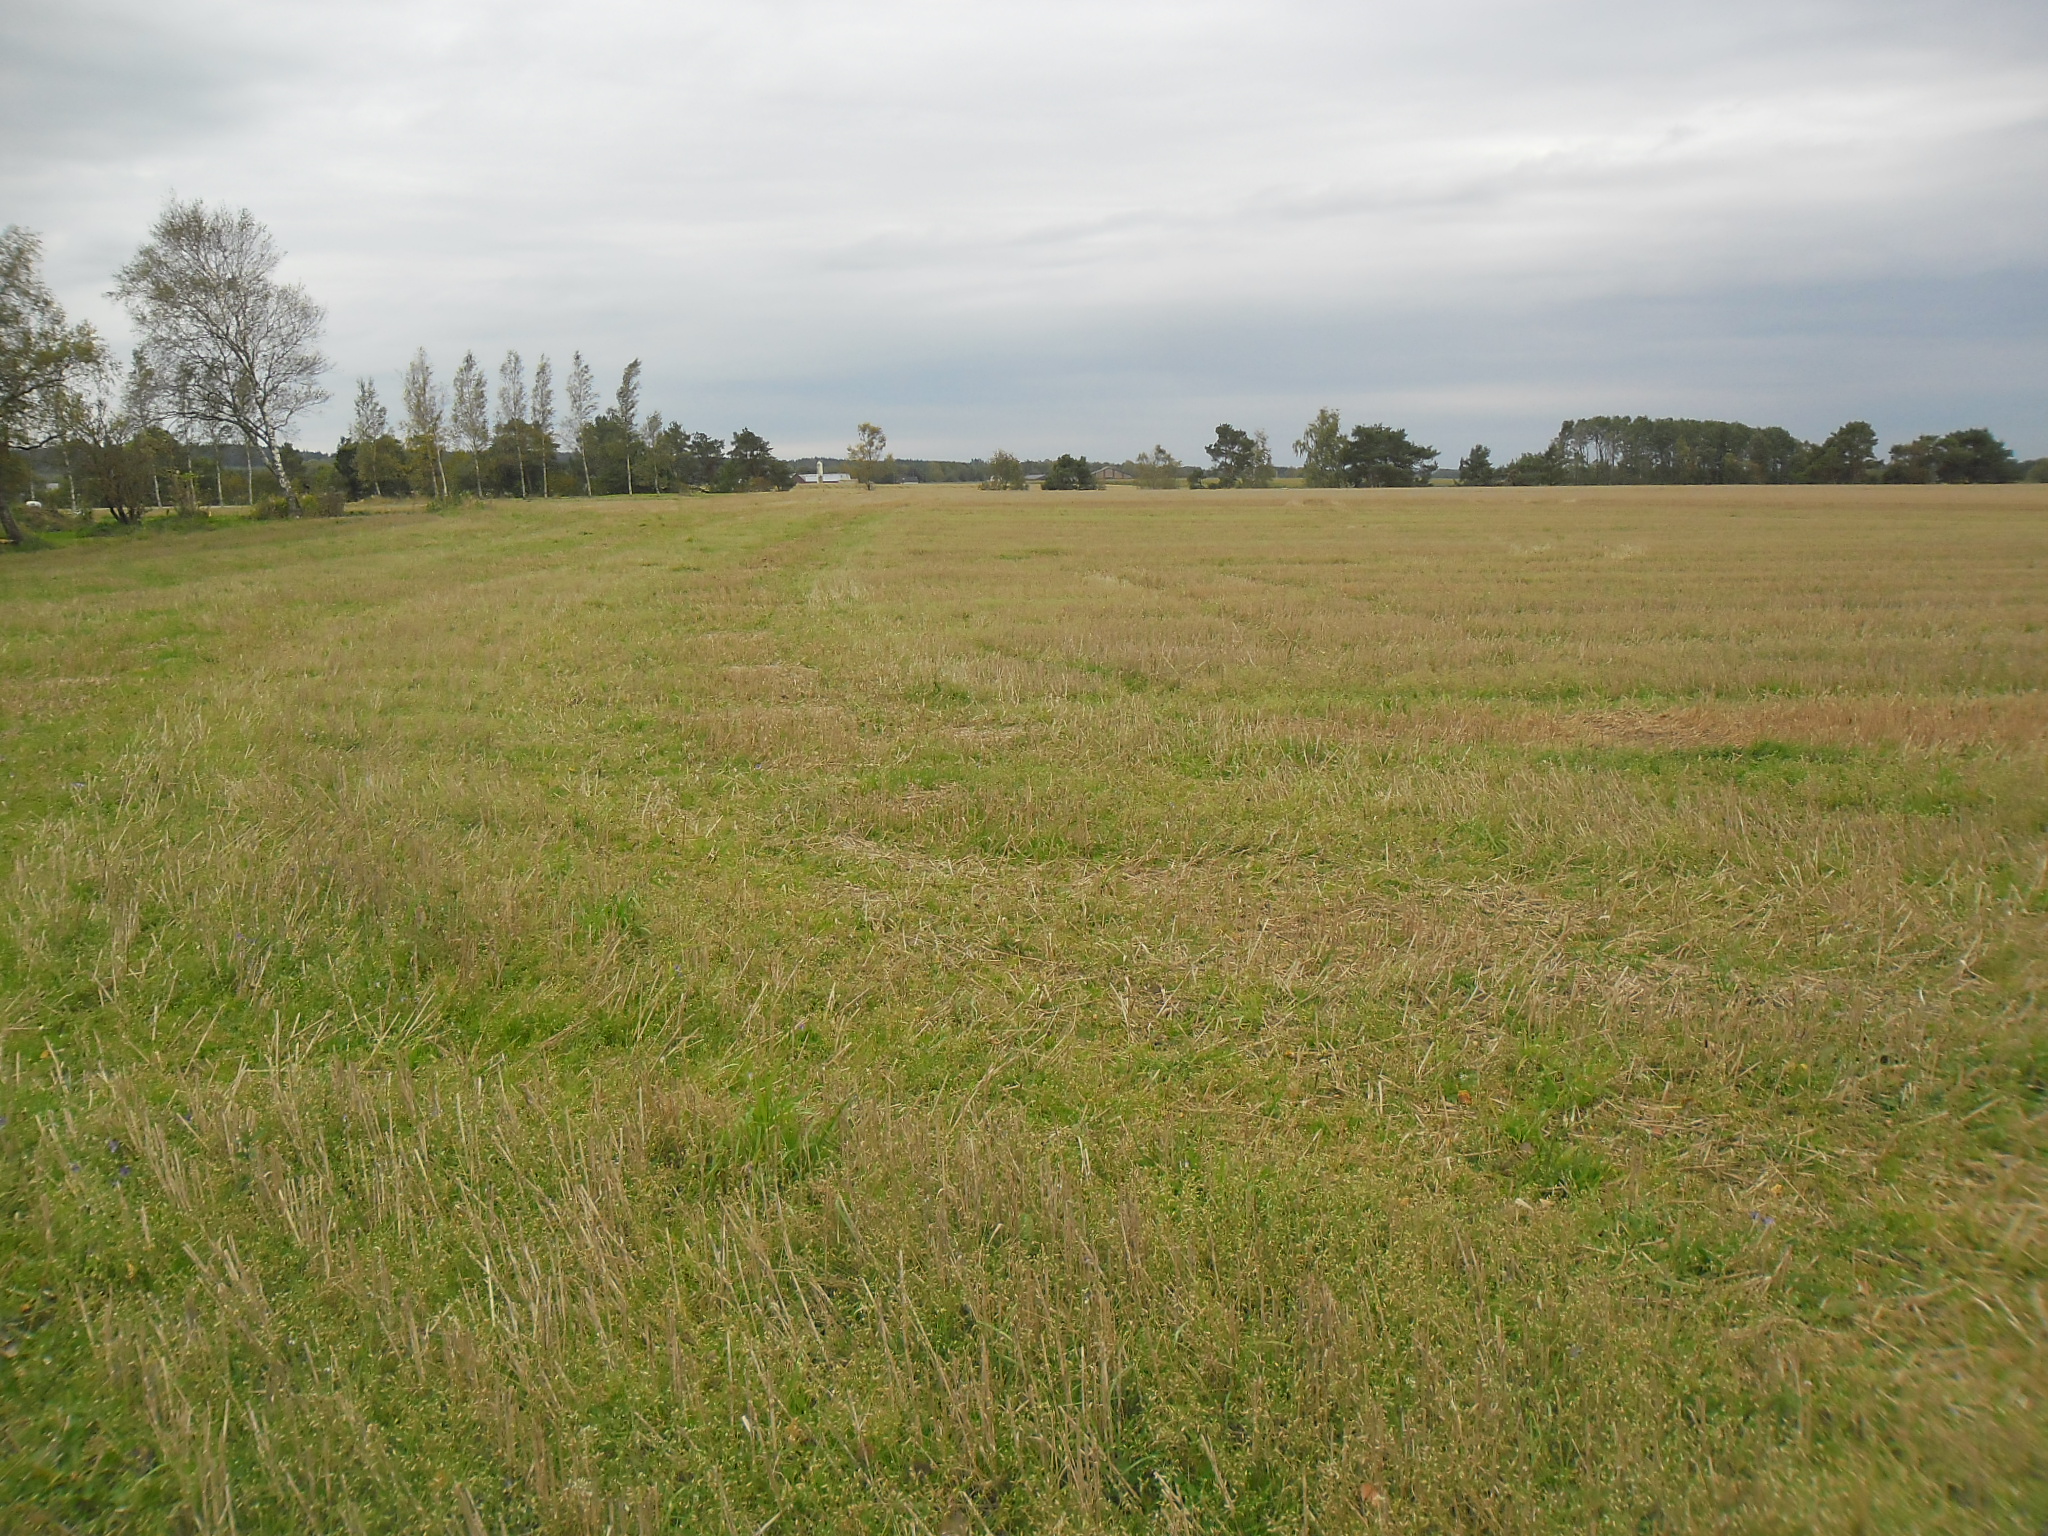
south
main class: Cropland
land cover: Common wheat
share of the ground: < 10 %
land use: Agriculture (excluding fallow land and kitchen gardens)
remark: Harvested field
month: October
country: SE
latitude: 56.5812
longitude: 13.1390
